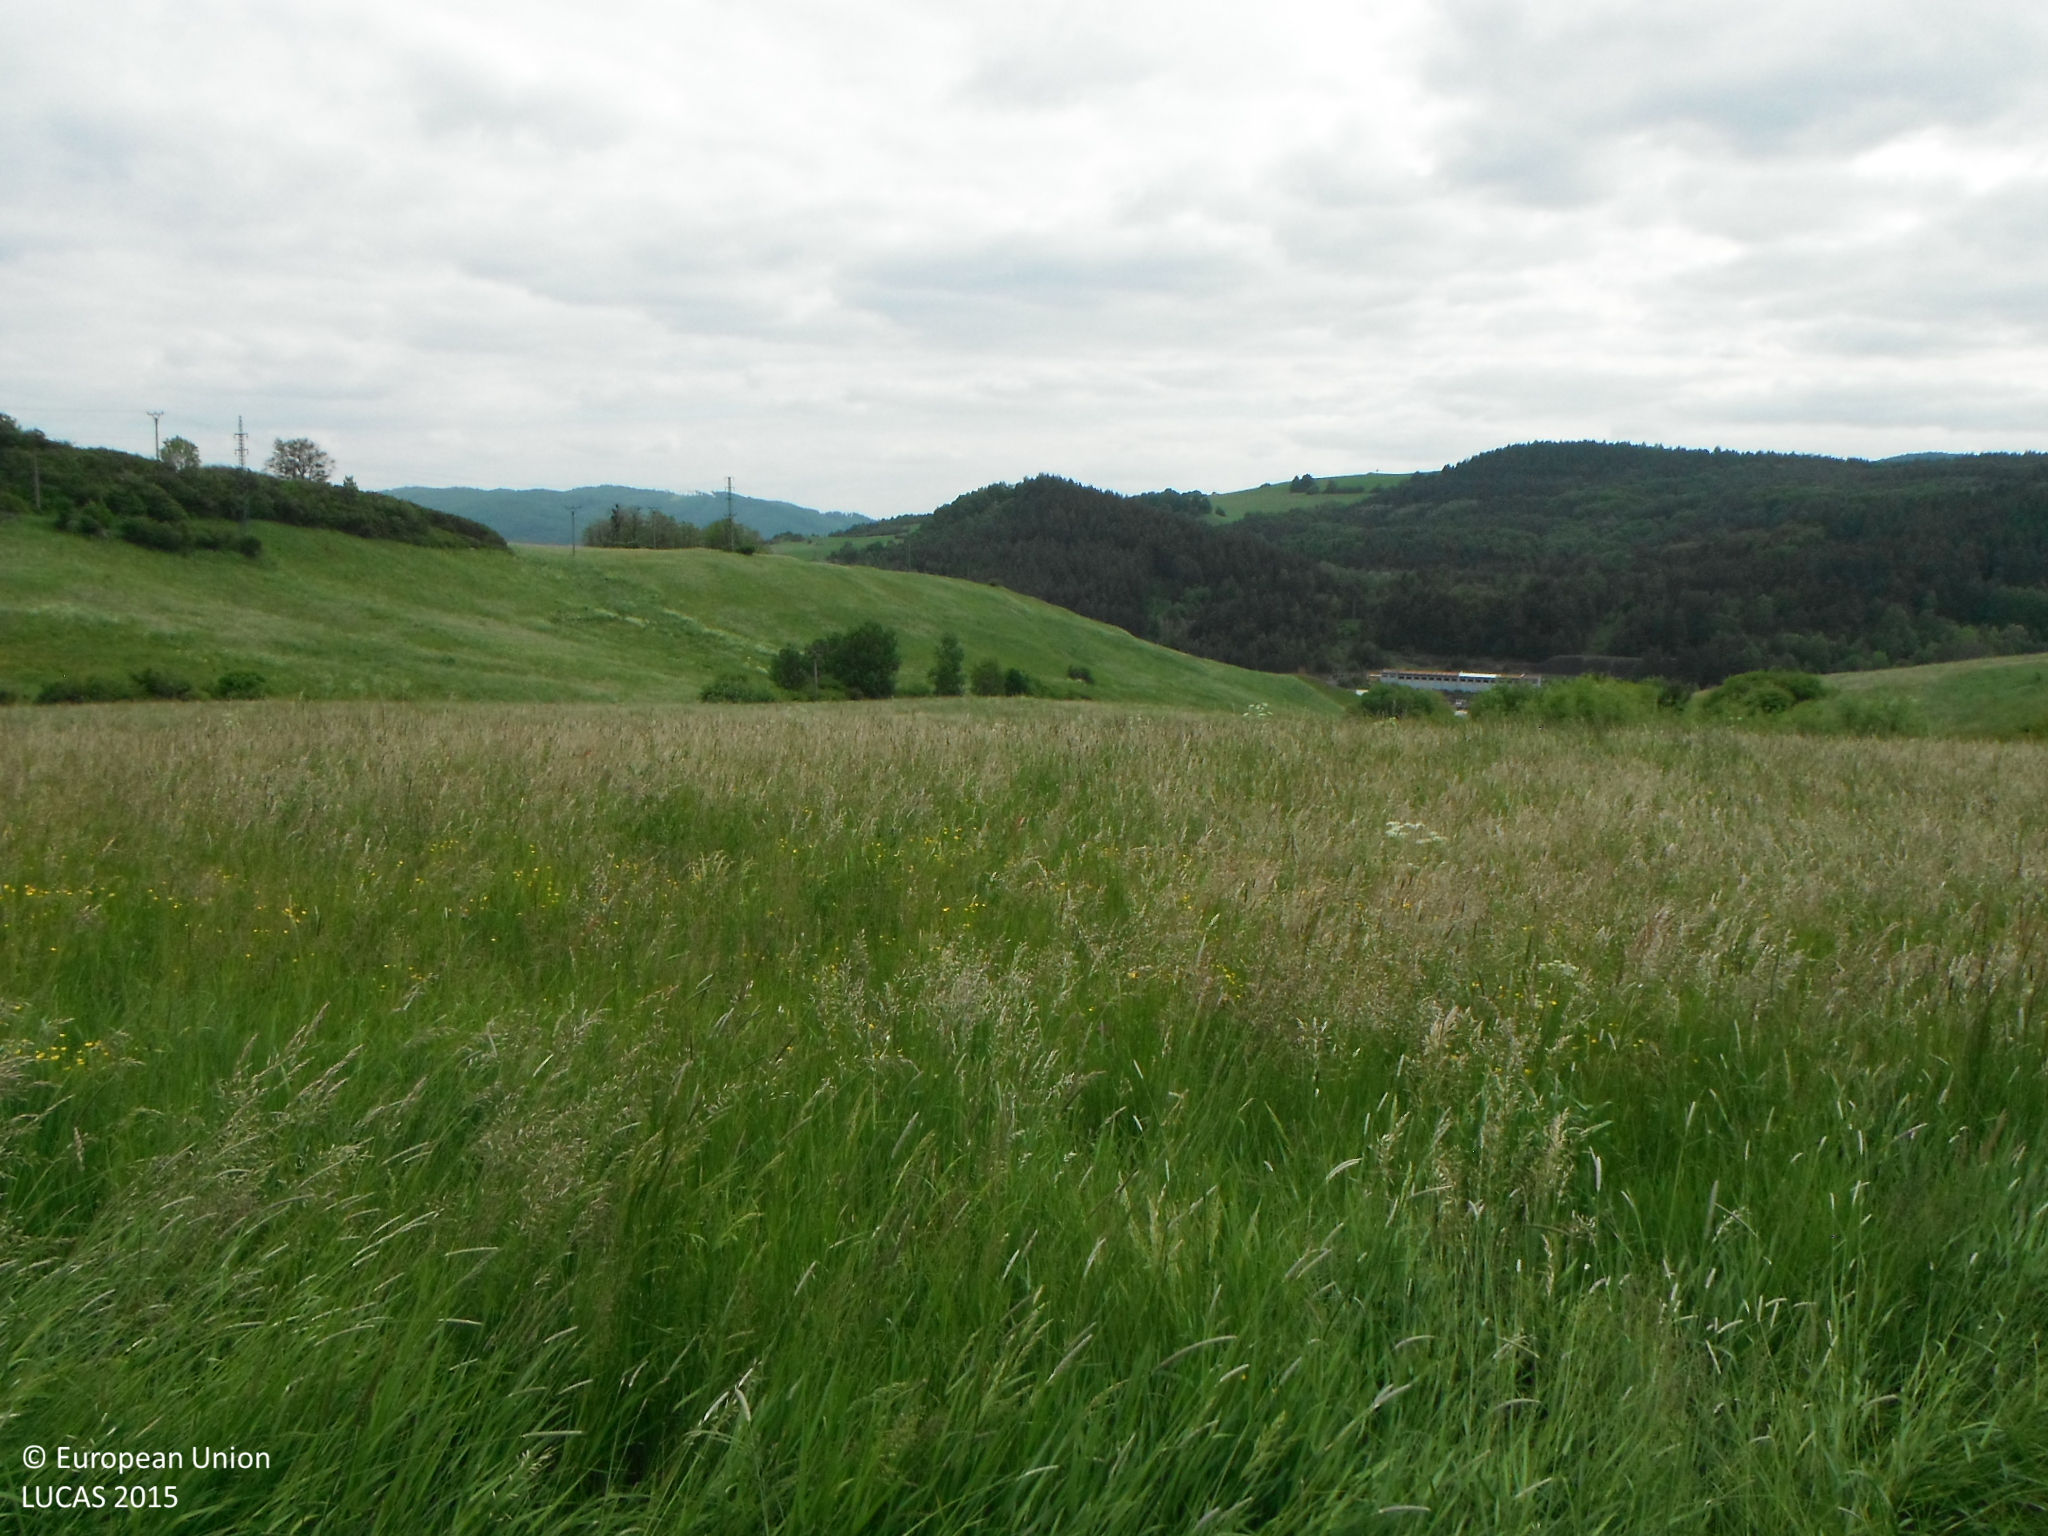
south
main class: Grassland
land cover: Grassland without tree/shrub cover
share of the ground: > 75 %
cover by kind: herbaceous plants 100 %
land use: Agriculture (excluding fallow land and kitchen gardens)
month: May
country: SK
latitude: 48.4400
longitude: 18.9281
